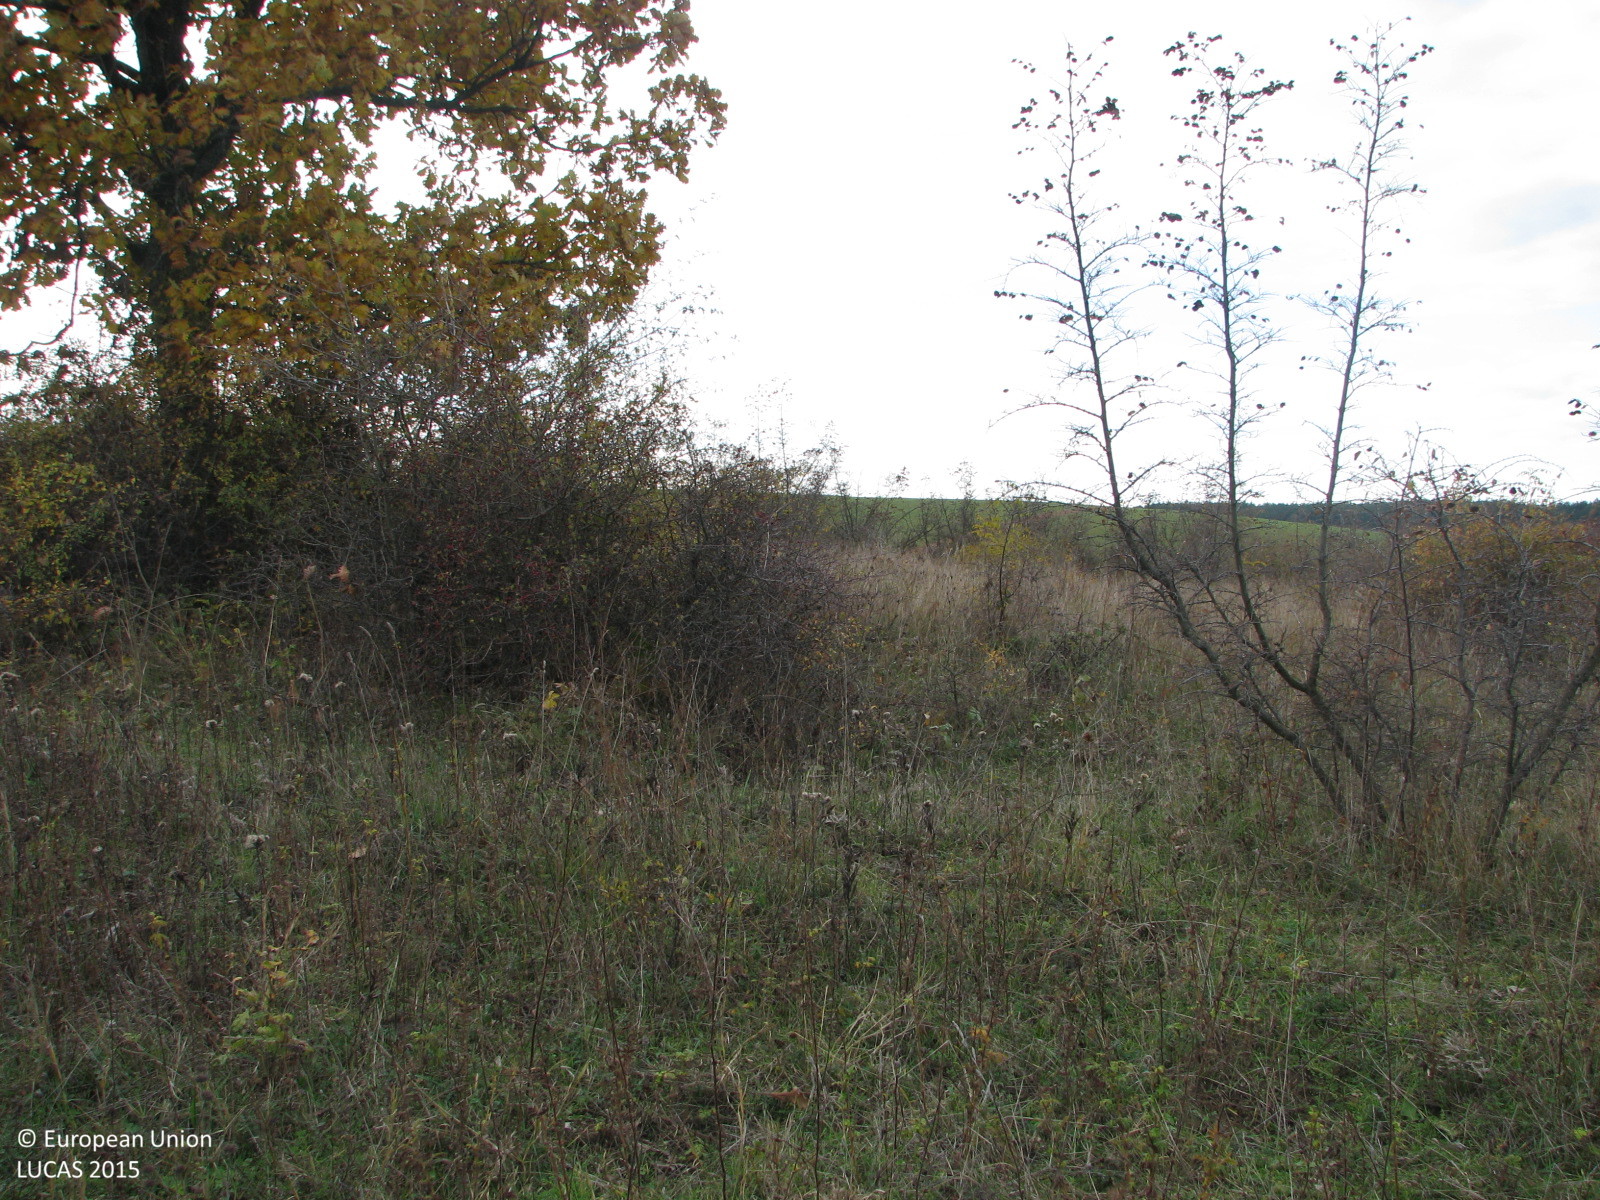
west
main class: Shrubland
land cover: Shrubland without tree cover
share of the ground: 50 - 75 %
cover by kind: shrubs 55 %, herbaceous plants 45 %
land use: Agriculture (excluding fallow land and kitchen gardens)
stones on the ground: < 10 %
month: November
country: BG
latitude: 41.9984
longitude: 26.4426
